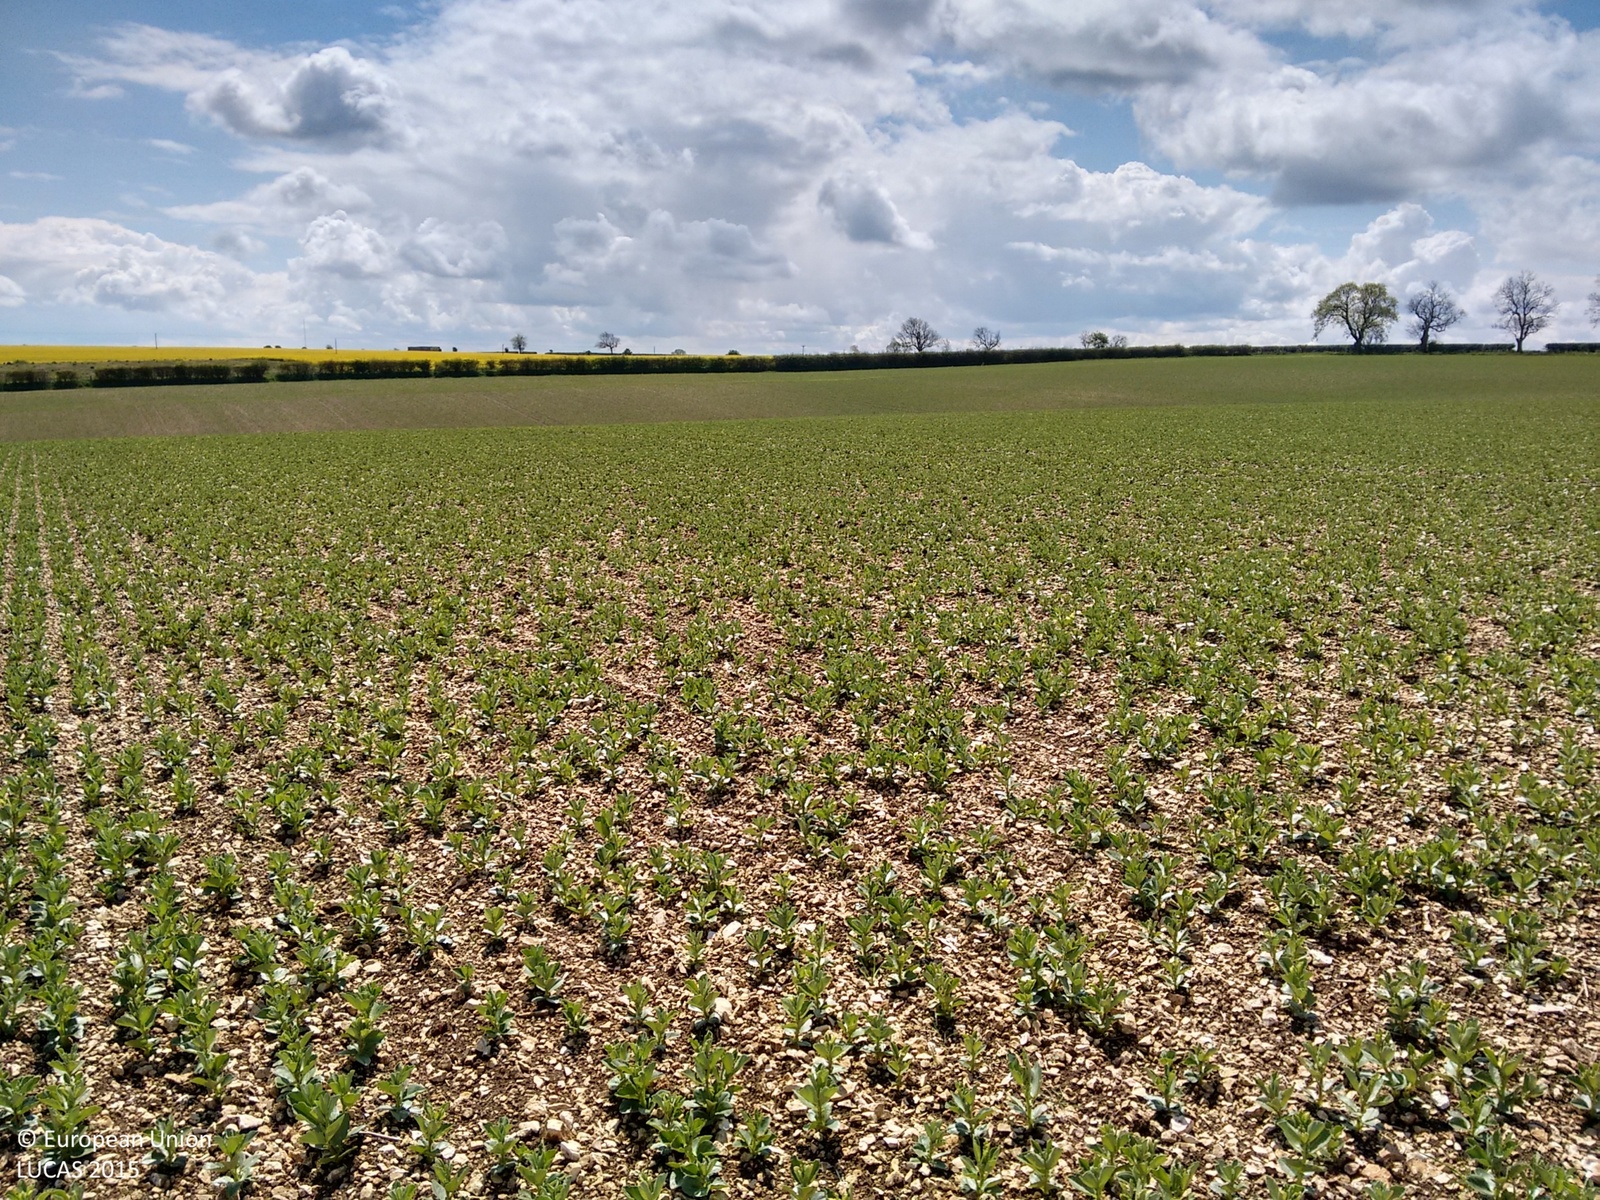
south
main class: Cropland
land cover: Dry pulses
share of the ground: 25 - 50 %
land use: Agriculture (excluding fallow land and kitchen gardens)
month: May
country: GB
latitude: 53.4240
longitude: -0.1916
